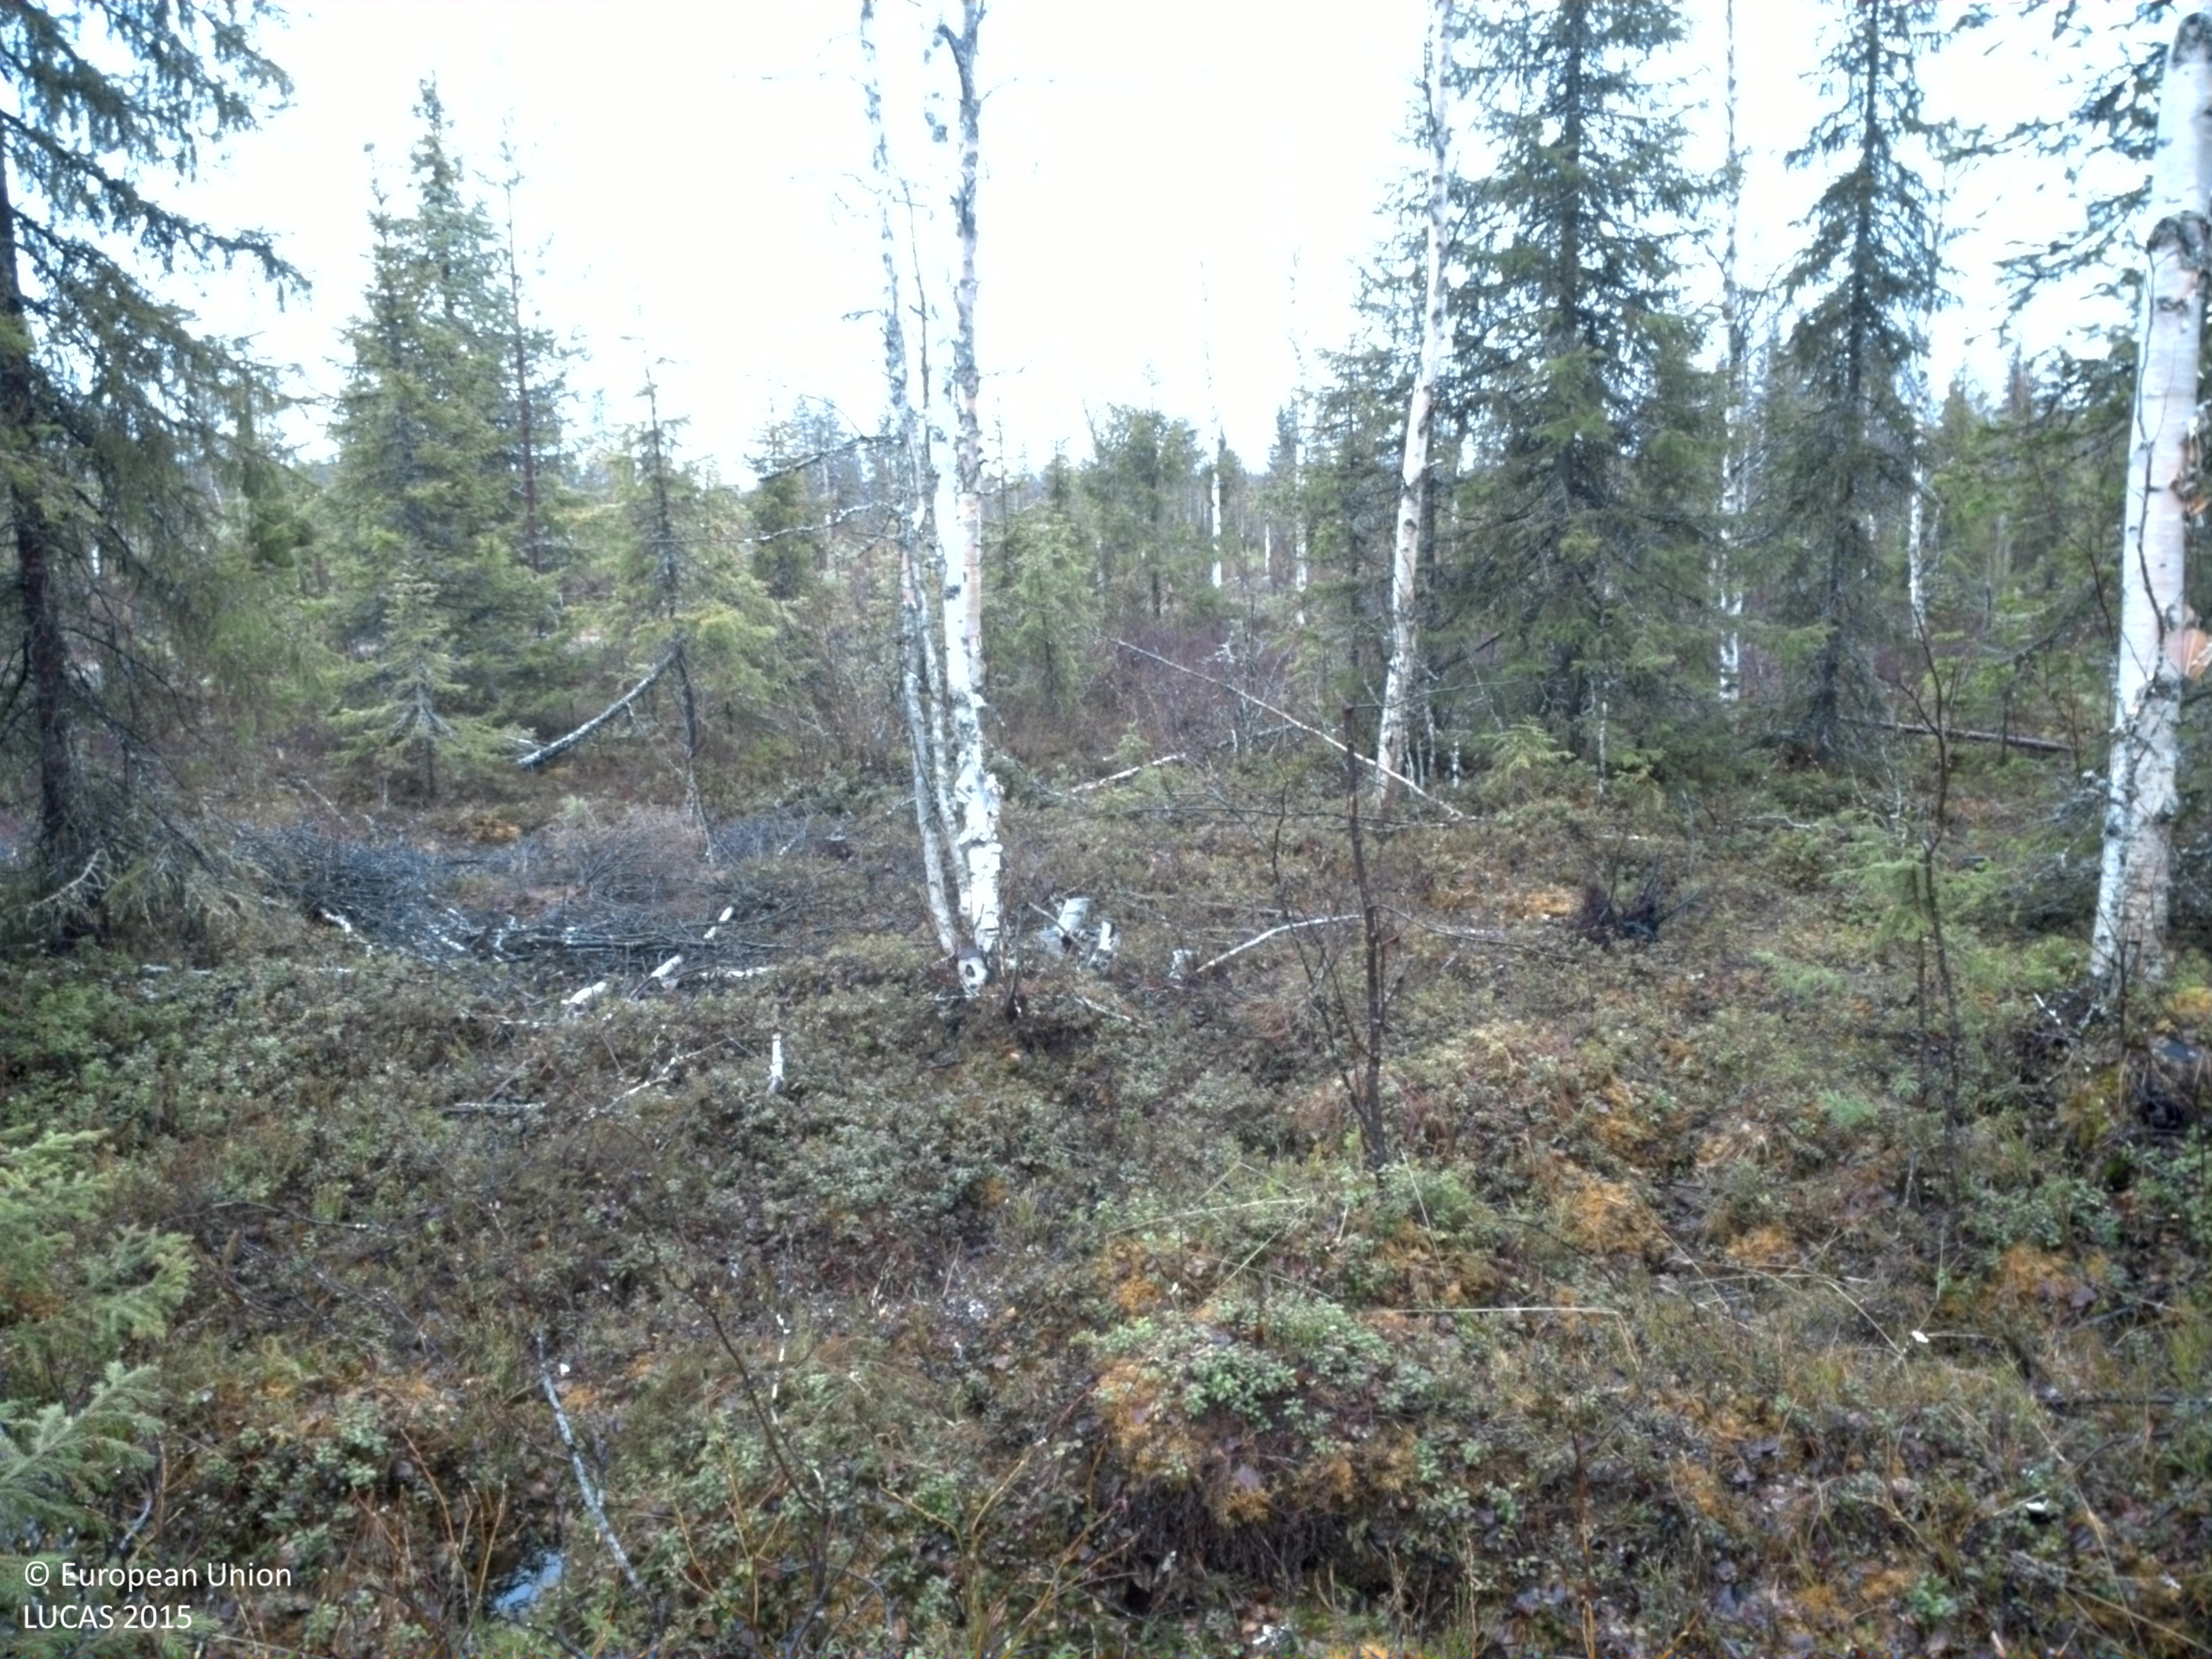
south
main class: Woodland
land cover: Spruce dominated mixed woodland
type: boreal forest
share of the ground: 50 - 75 %
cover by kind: coniferous forest trees 45 %, shrubs 25 %, broadleaved forest trees 15 %, lichens and mosses 15 %
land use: Forestry
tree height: > 5 m
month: May
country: SE
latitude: 66.5262
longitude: 23.2311
